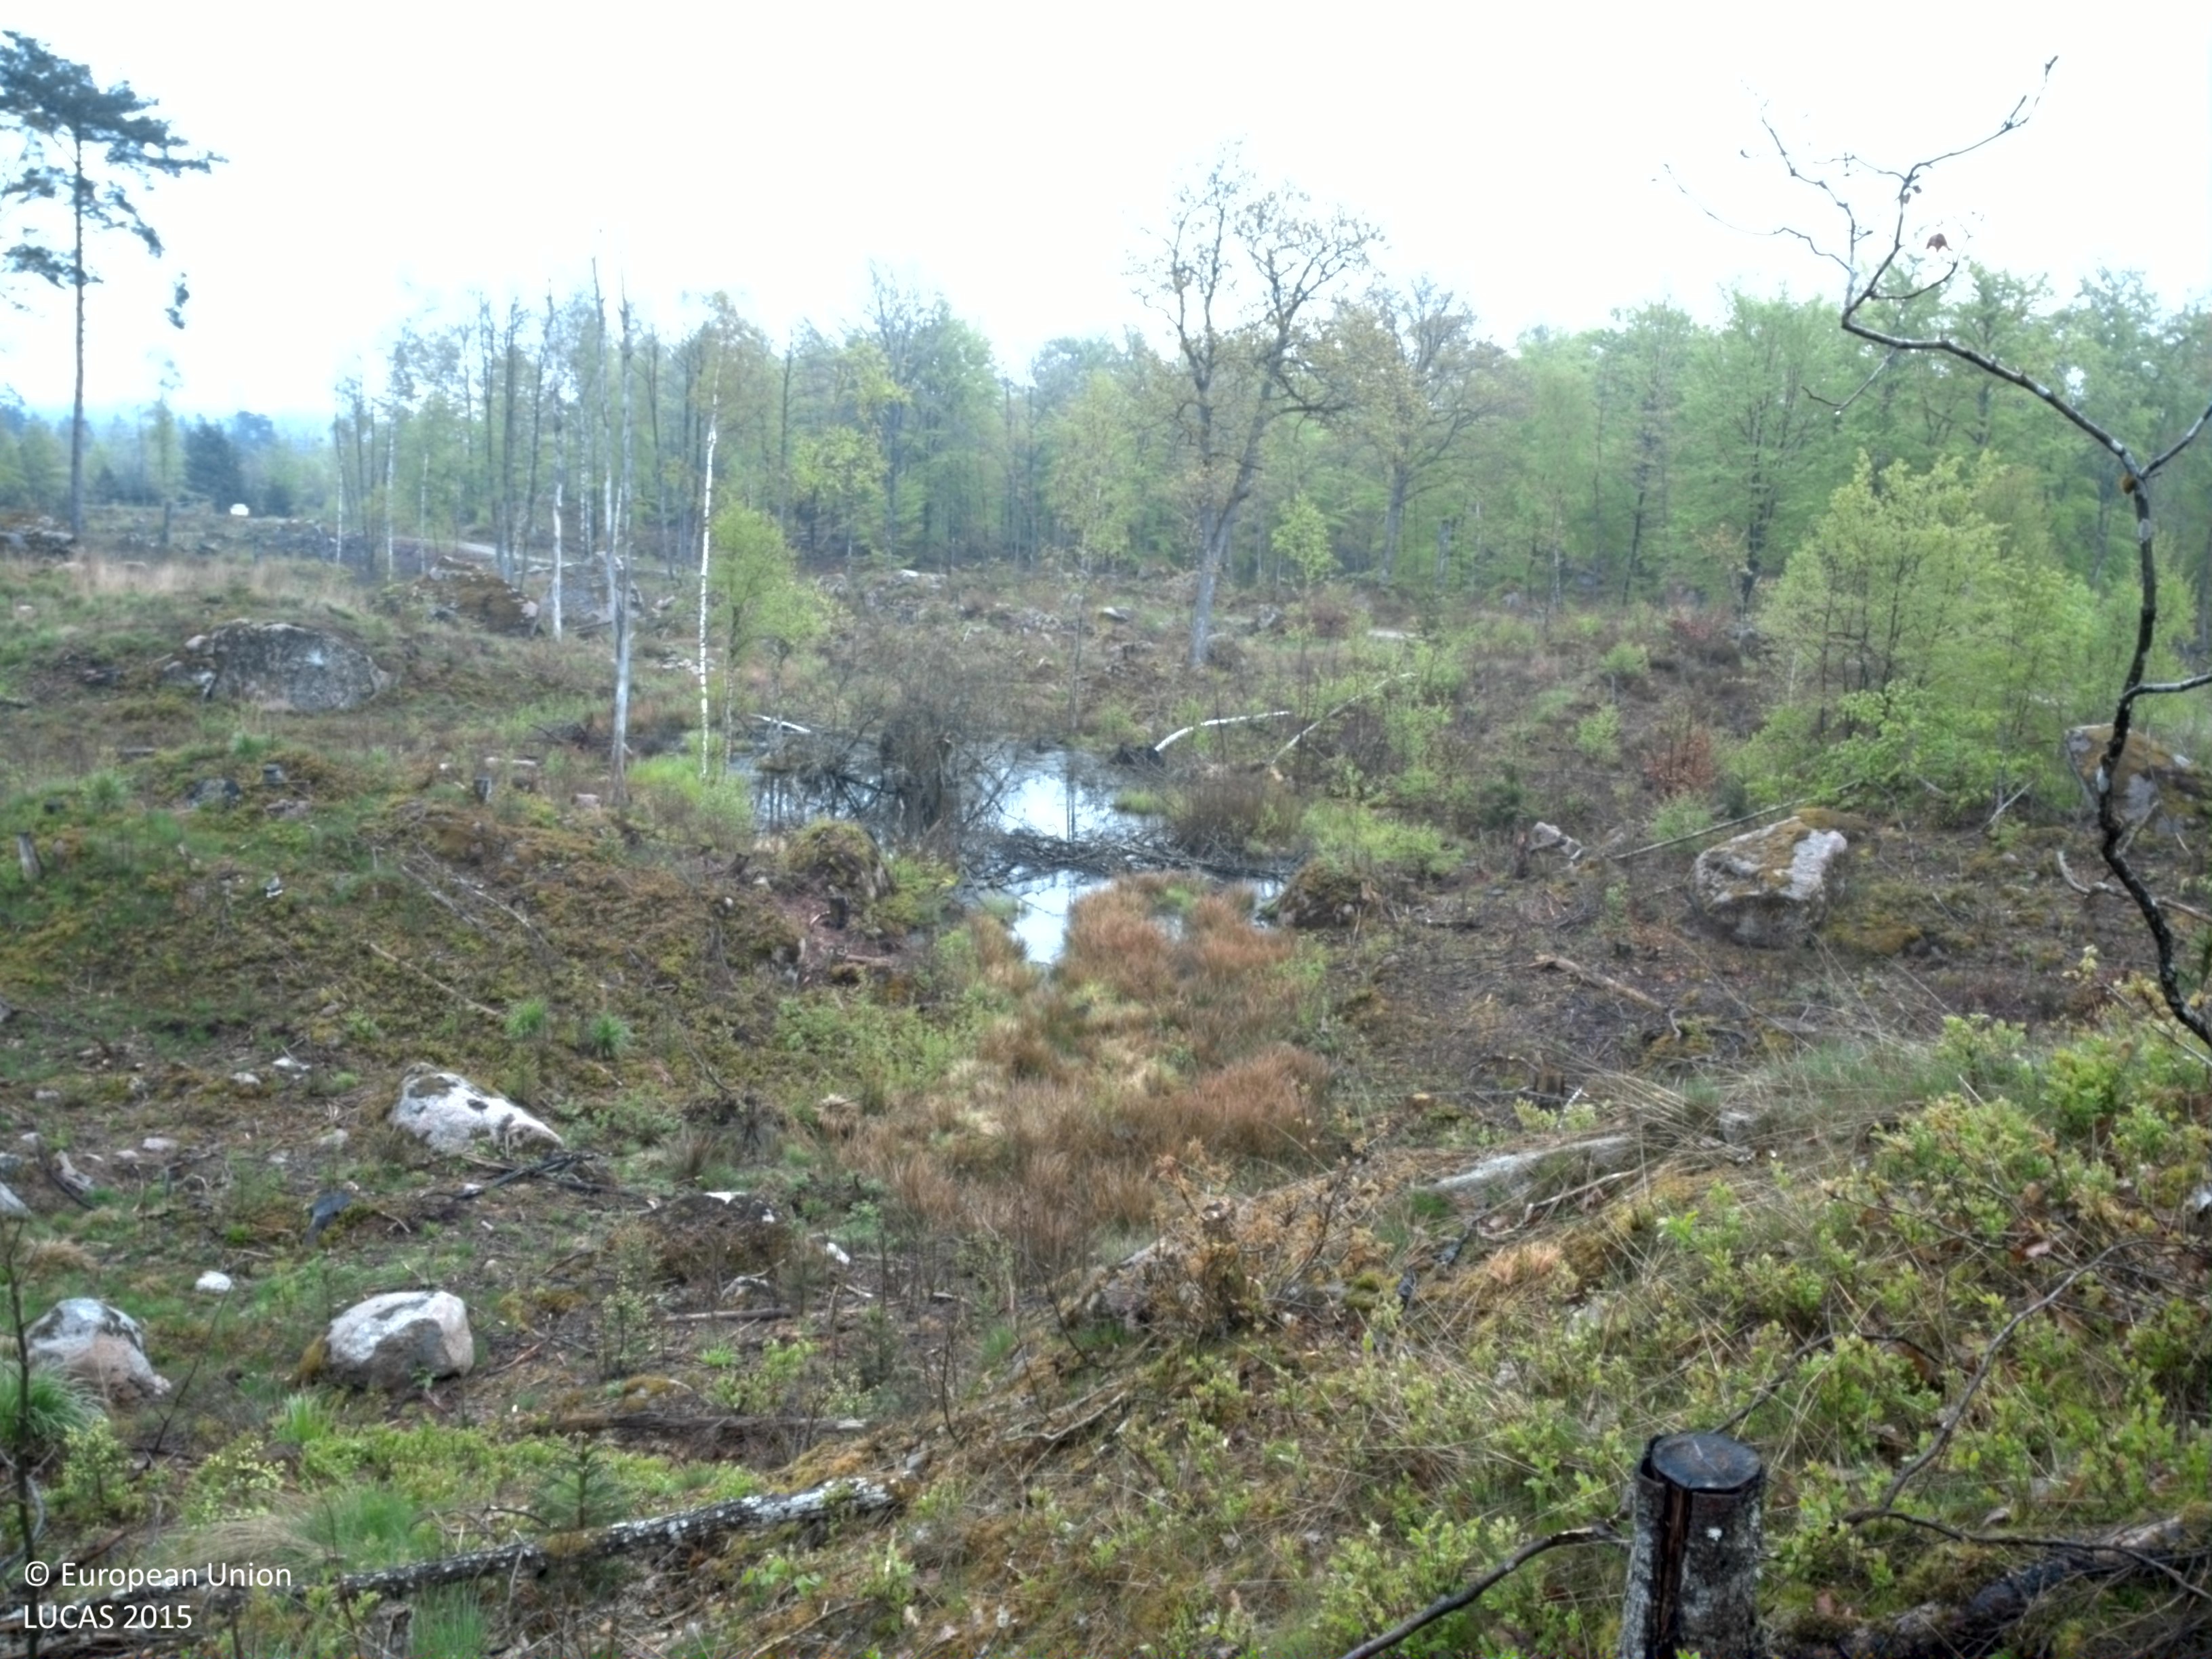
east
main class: Shrubland
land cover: Shrubland with sparse tree cover
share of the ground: 50 - 75 %
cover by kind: shrubs 65 %, herbaceous plants 25 %, coniferous forest trees 5 %, lichens and mosses 5 %
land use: Forestry
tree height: < 5 m
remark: Clear cut
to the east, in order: Shrubland with sparse tree cover; Paved roads, cycling and walking lanes; Broadleaved woodland; Ditches and canals; Broadleaved woodland; Tracks; Pine dominated mixed woodland
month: May
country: SE
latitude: 56.3616
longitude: 15.4216
